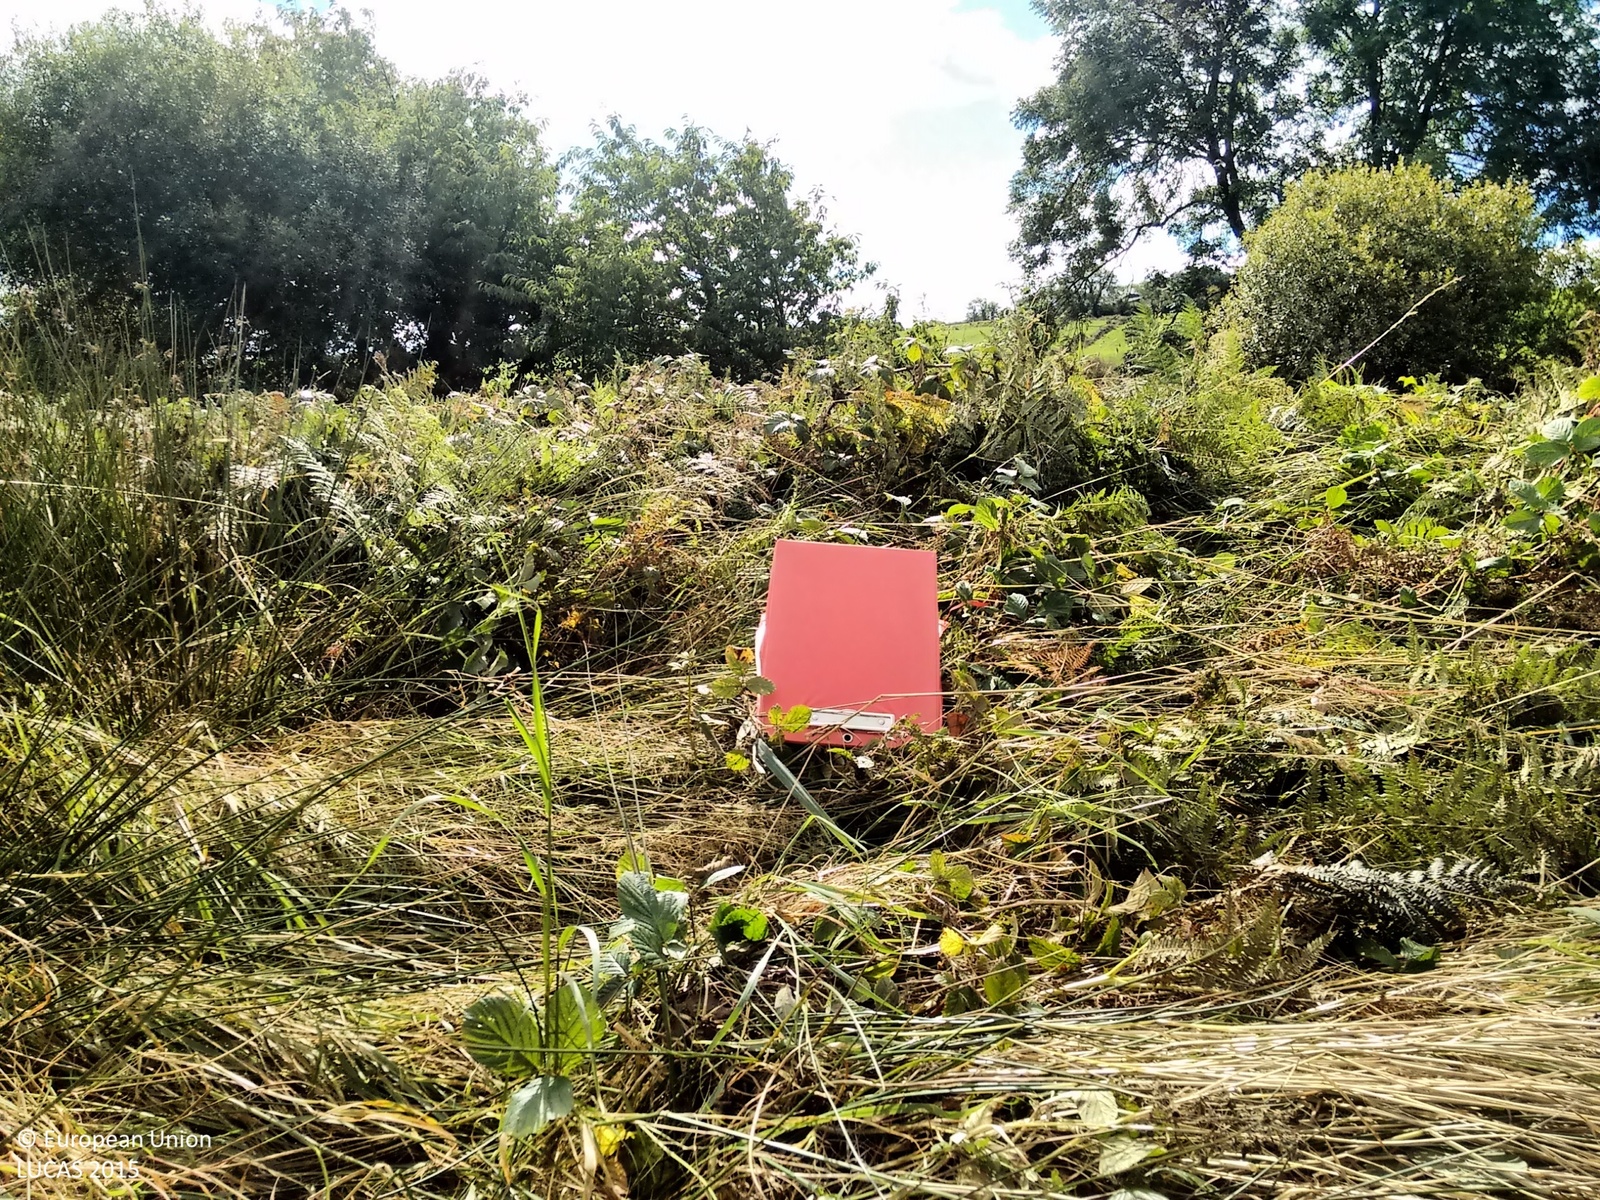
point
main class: Grassland
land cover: Grassland with sparse tree/shrub cover
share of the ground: > 75 %
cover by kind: herbaceous plants 90 %, broadleaved forest trees 5 %, shrubs 5 %
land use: Agriculture (excluding fallow land and kitchen gardens)
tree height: < 5 m
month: September
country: IE
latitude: 52.3914
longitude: -9.4669
